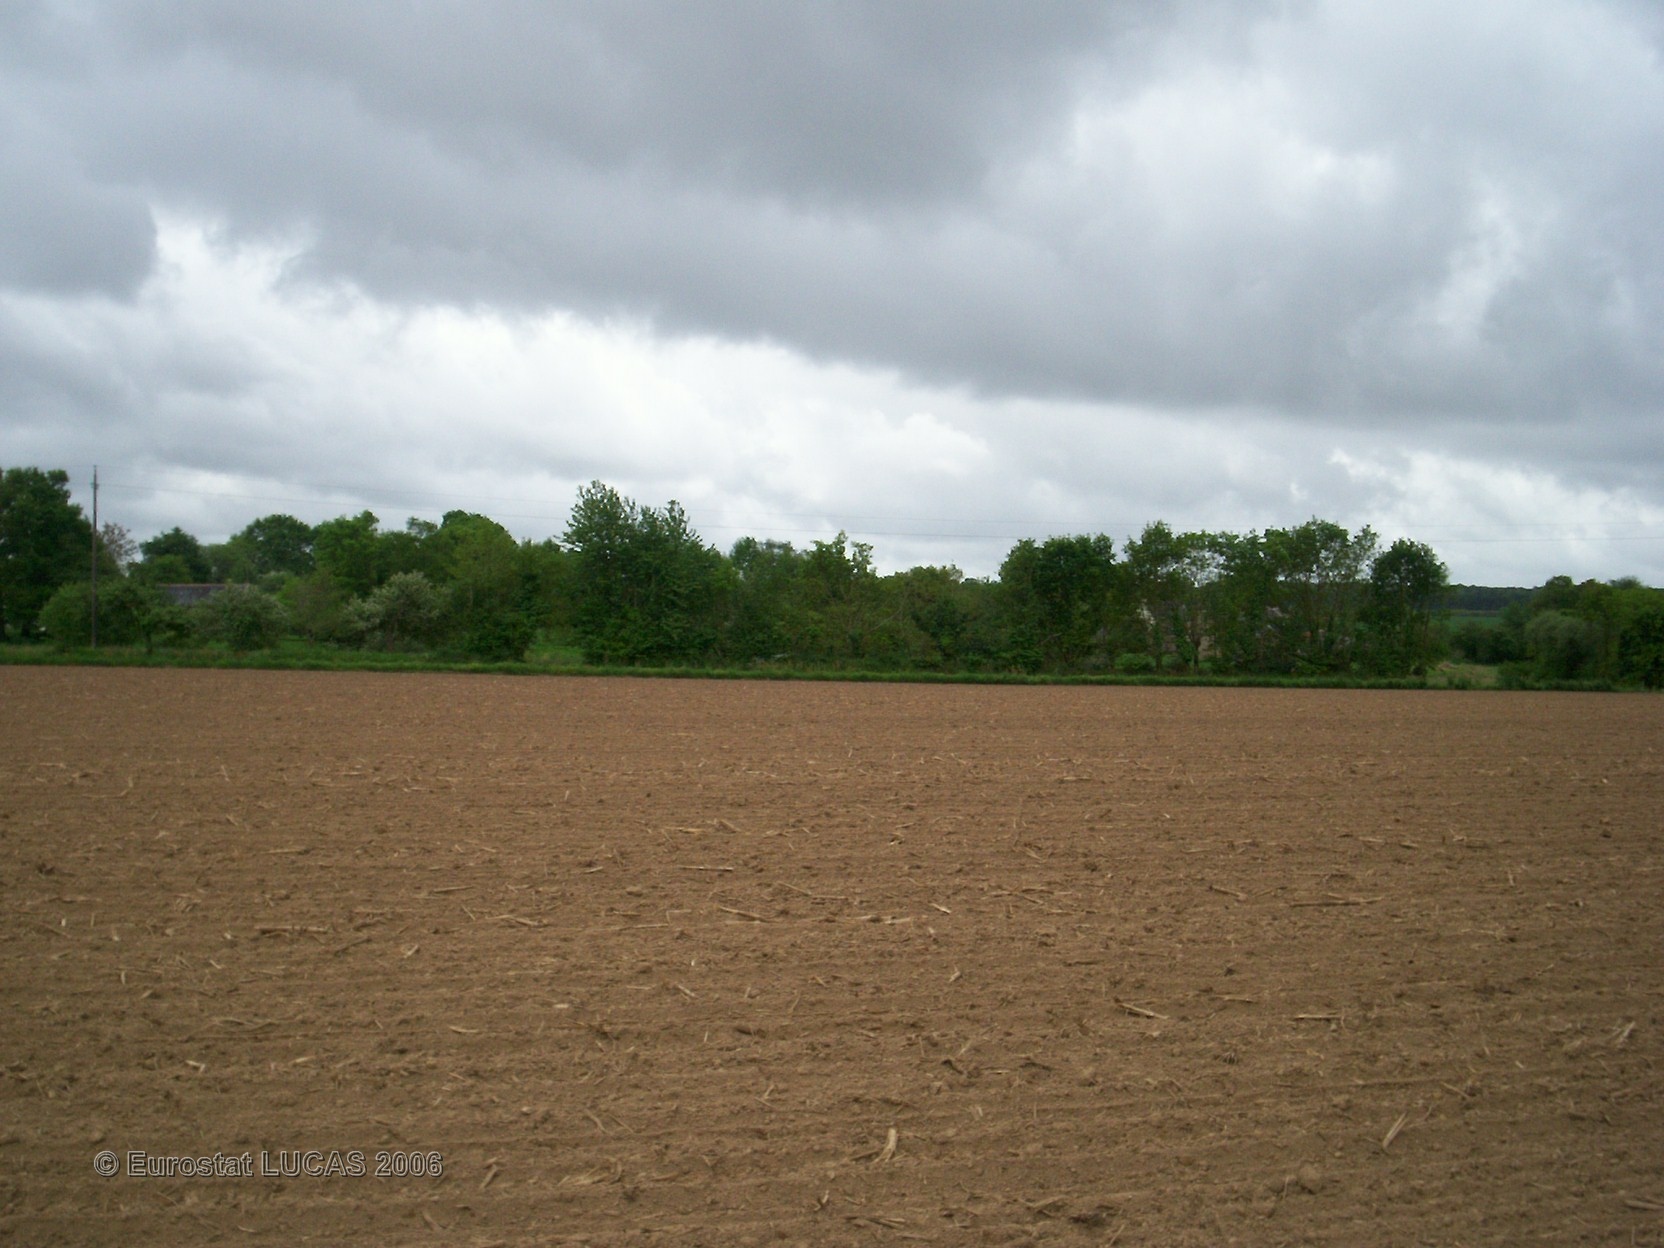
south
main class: Cropland
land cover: Maize
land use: Agriculture (excluding fallow land and kitchen gardens)
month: May
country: FR
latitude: 47.9237
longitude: -2.8455
